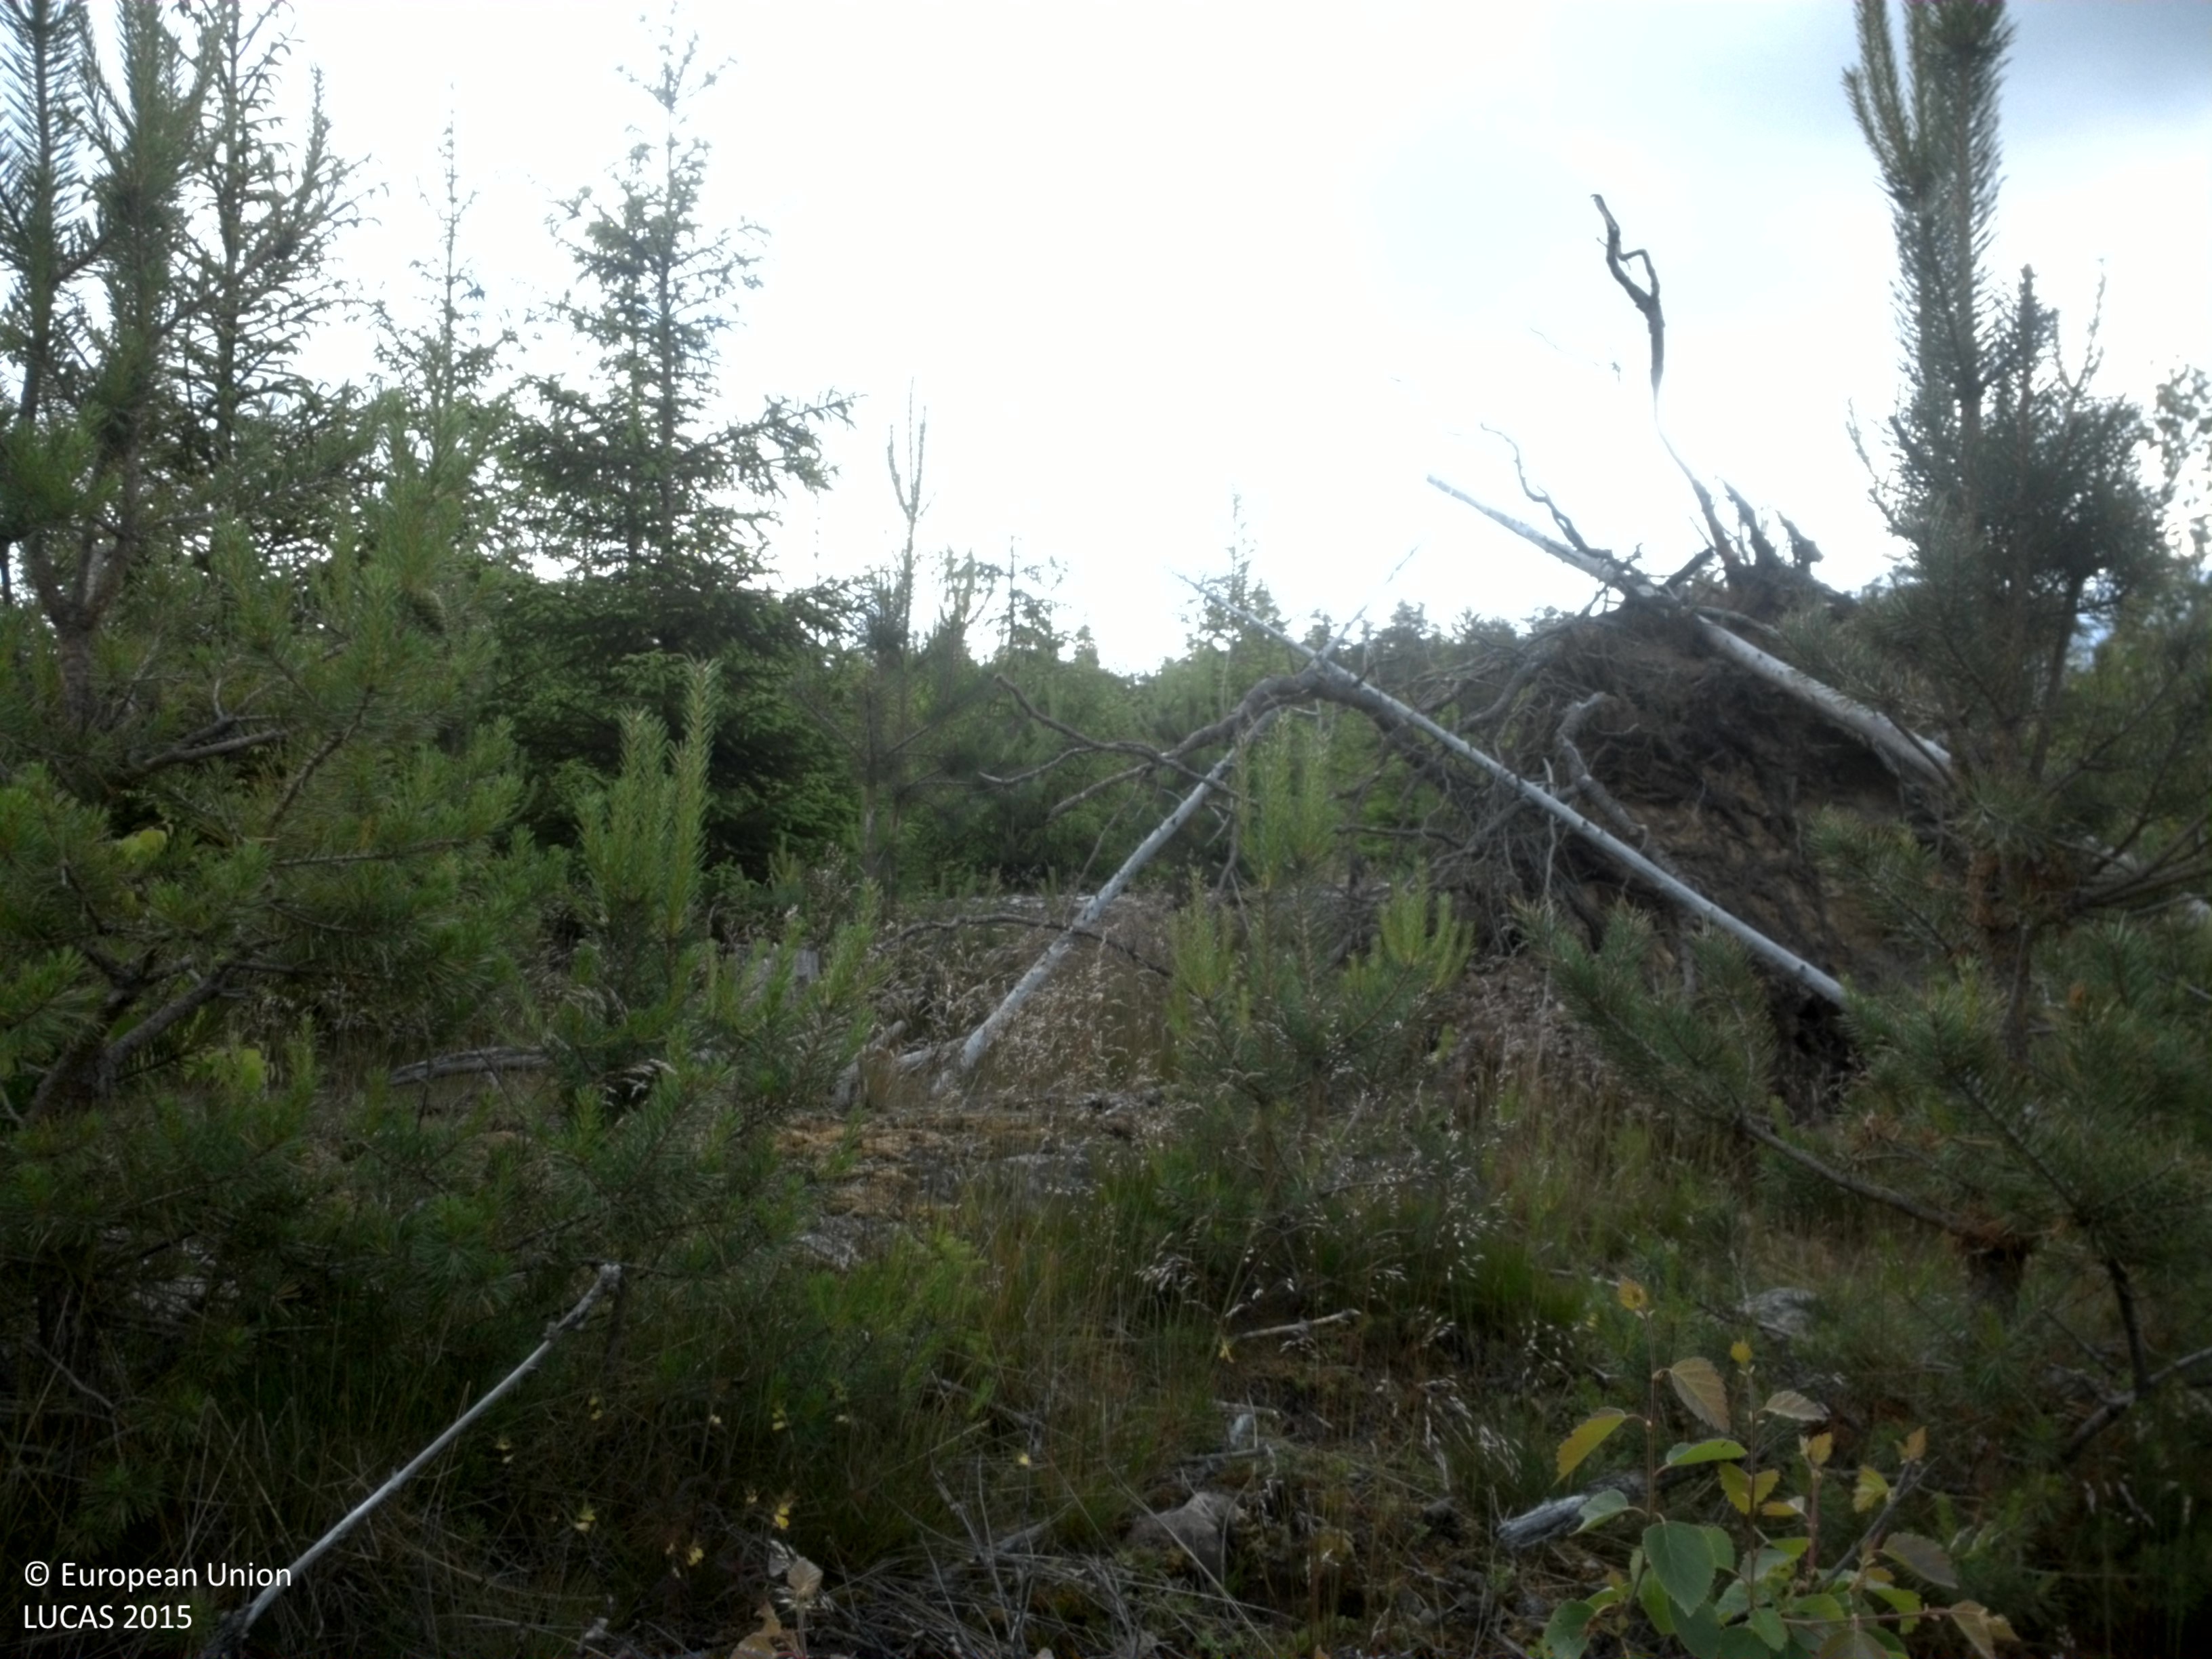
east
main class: Woodland
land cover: Spruce dominated coniferous woodland
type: boreal forest
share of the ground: 50 - 75 %
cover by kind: coniferous forest trees 60 %, herbaceous plants 30 %, broadleaved forest trees 5 %, lichens and mosses 5 %
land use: Forestry
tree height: < 5 m
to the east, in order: Spruce dominated coniferous woodland; Pine dominated mixed woodland; Pine dominated coniferous woodland
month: June
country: SE
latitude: 58.6356
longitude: 15.7993
